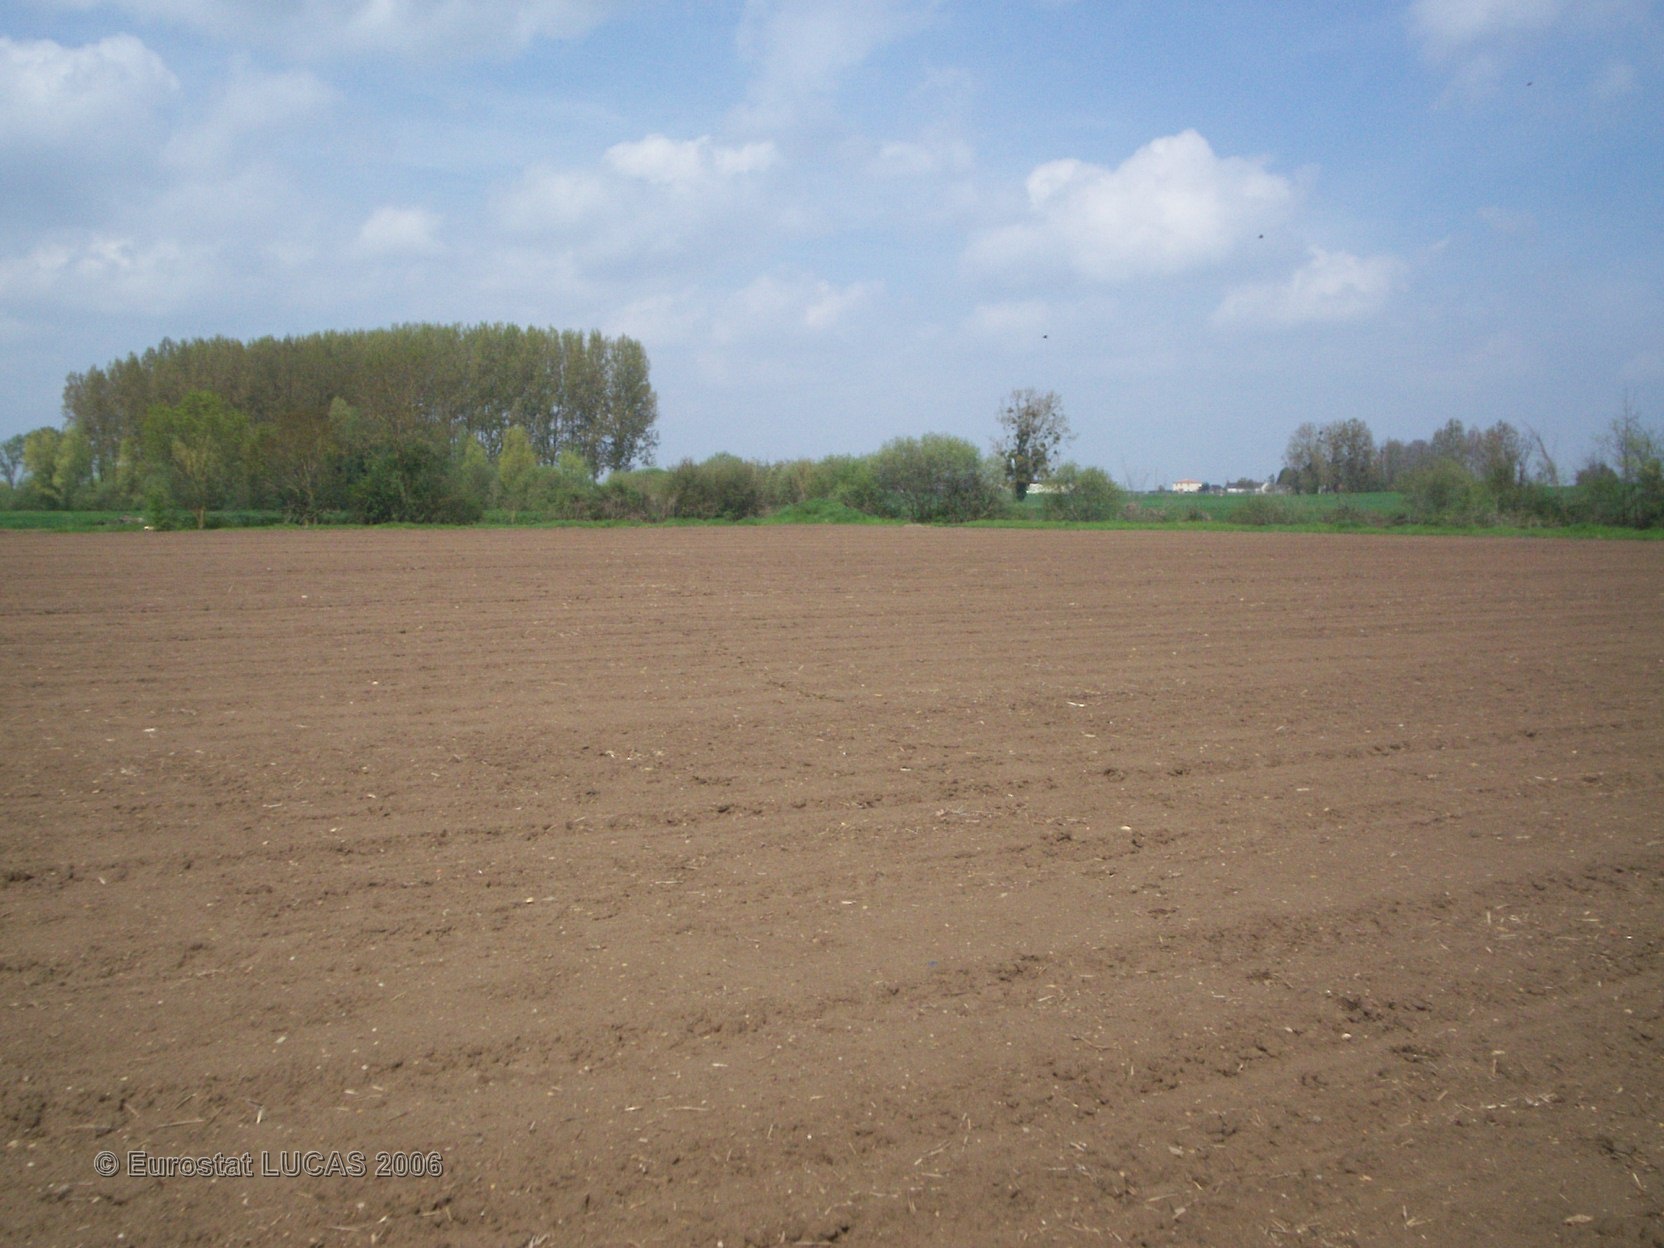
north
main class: Cropland
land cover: Sunflower
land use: Agriculture (excluding fallow land and kitchen gardens)
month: April
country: FR
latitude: 47.2608
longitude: -0.3764
